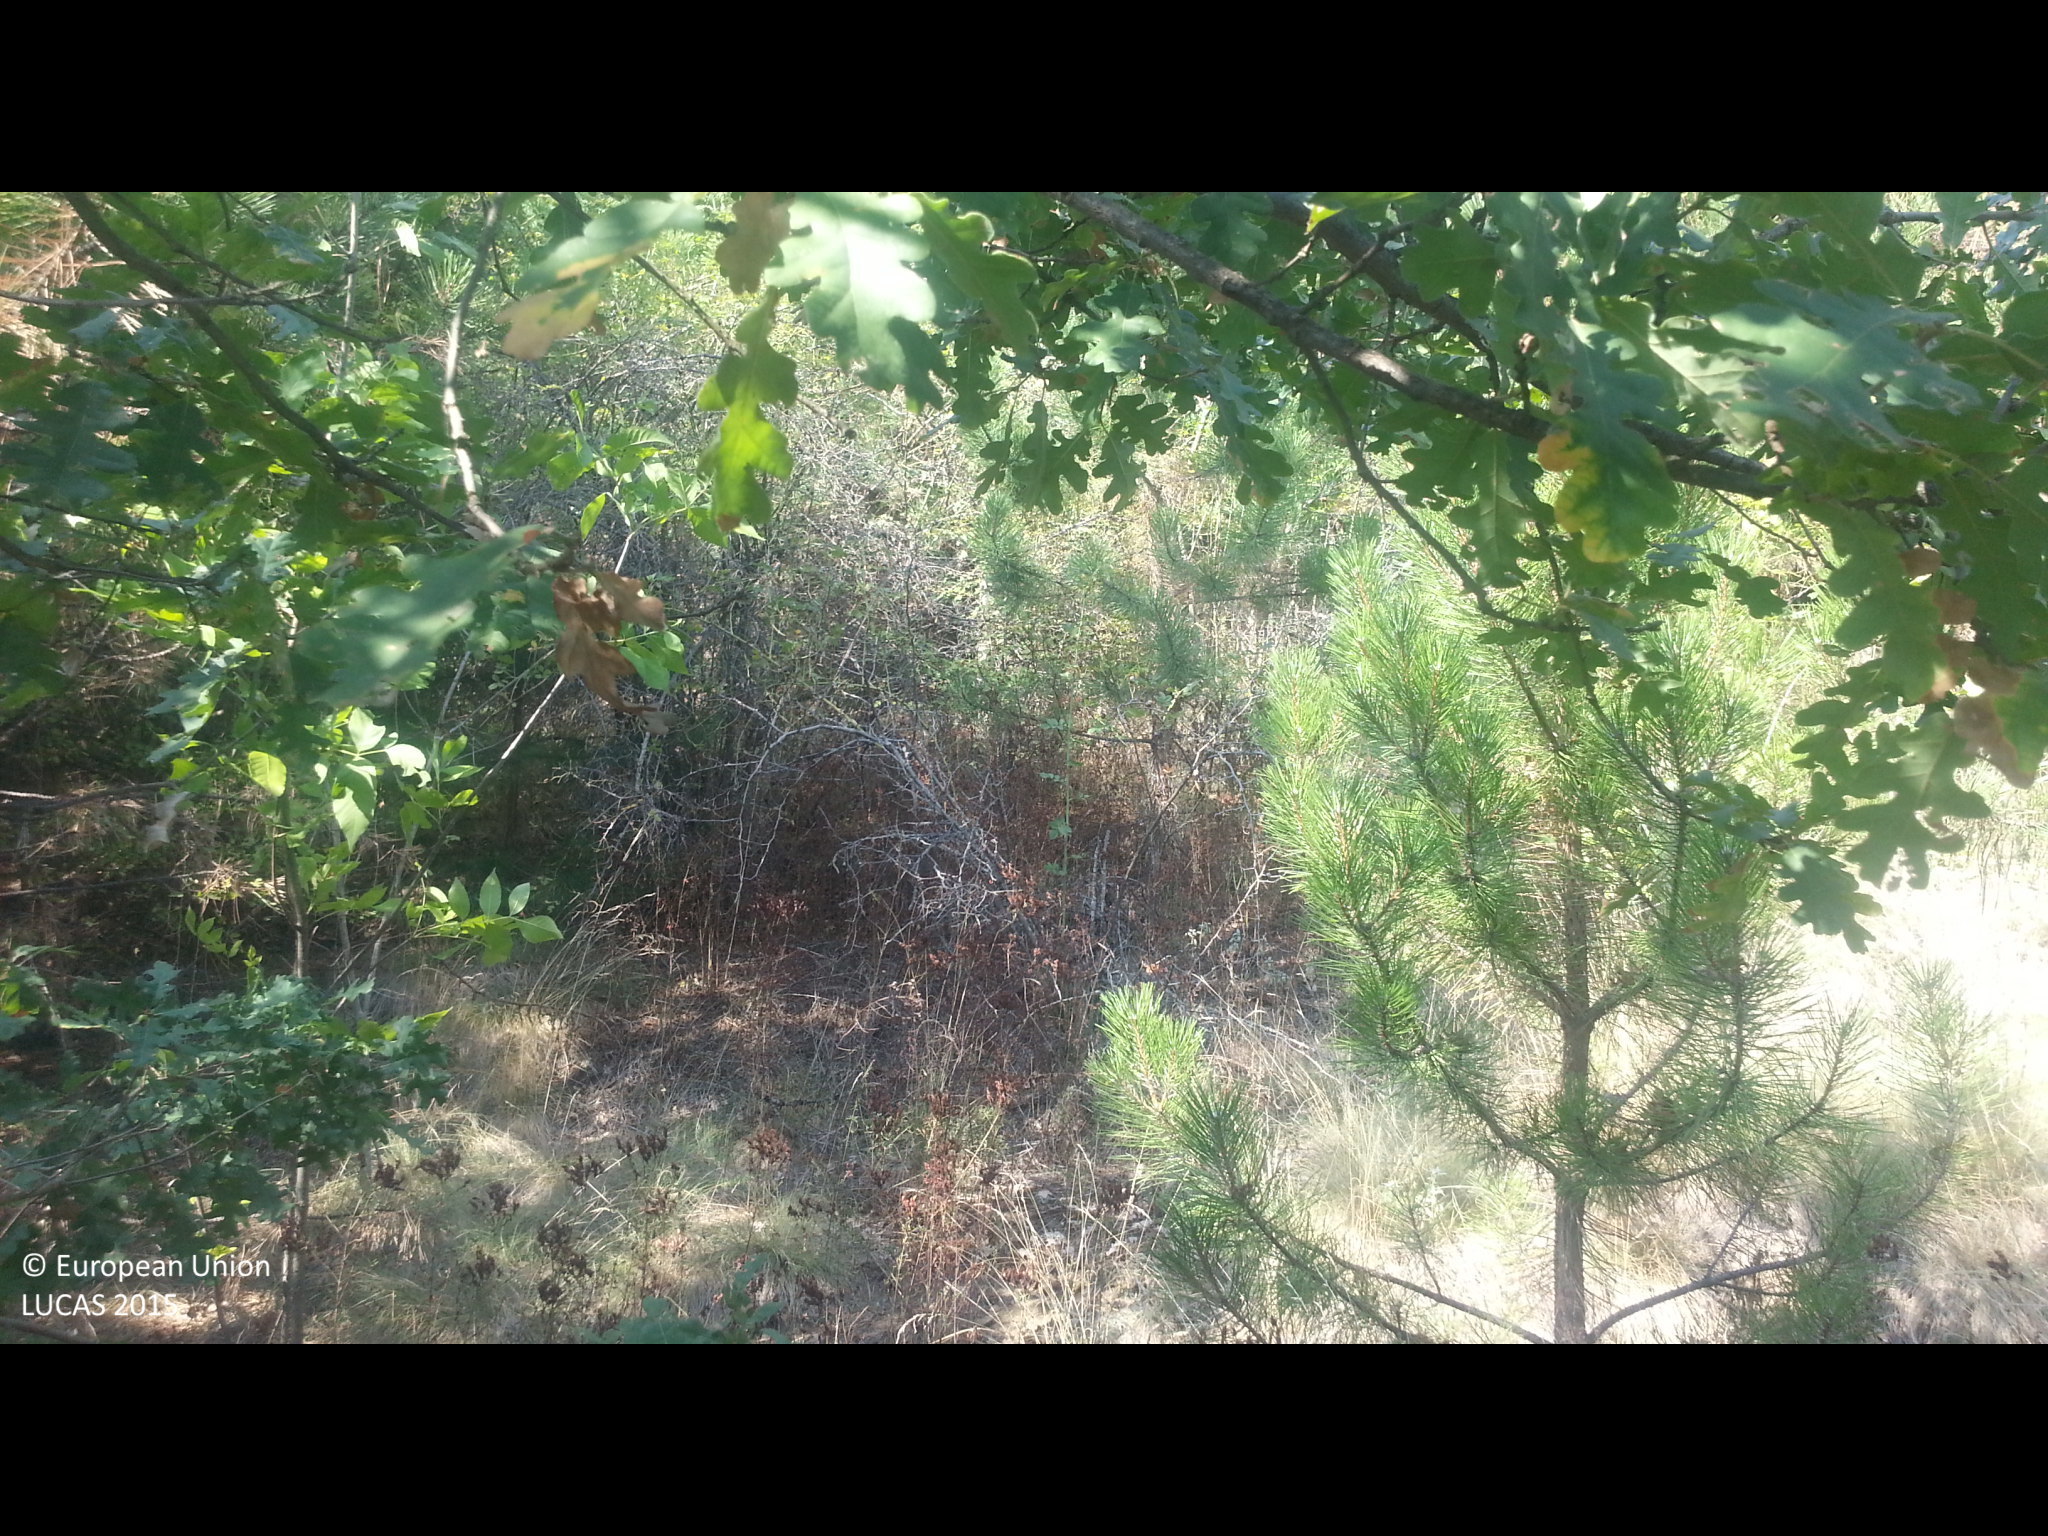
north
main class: Woodland
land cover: Other mixed woodland
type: hemiboreal forest and nemoral coniferous forest and mixed broadleaved-coniferous forest
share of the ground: > 75 %
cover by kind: coniferous forest trees 75 %, broadleaved forest trees 25 %
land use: Forestry
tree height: < 5 m
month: August
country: BG
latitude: 42.3680
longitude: 23.0814
